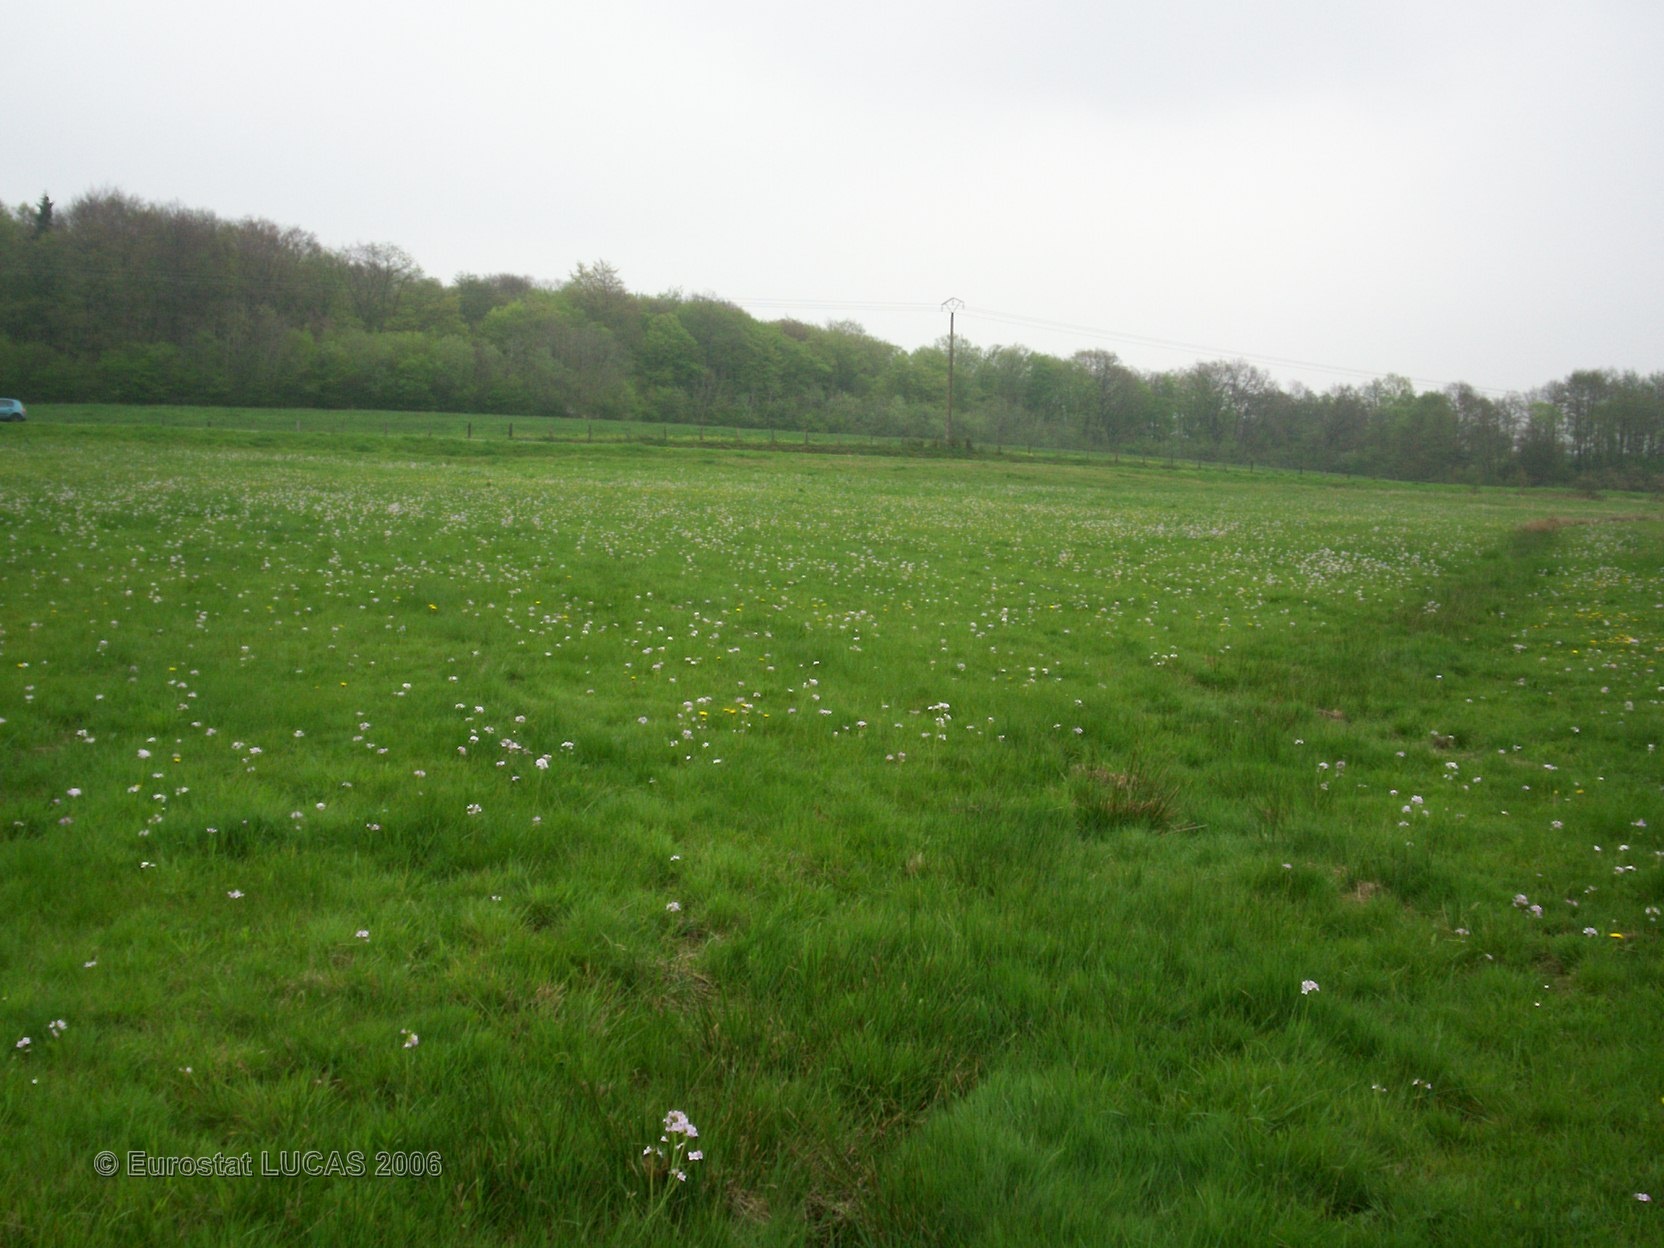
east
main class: Grassland
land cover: Grassland without tree/shrub cover
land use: Agriculture (excluding fallow land and kitchen gardens)
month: April
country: FR
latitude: 48.9136
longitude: 6.7391
